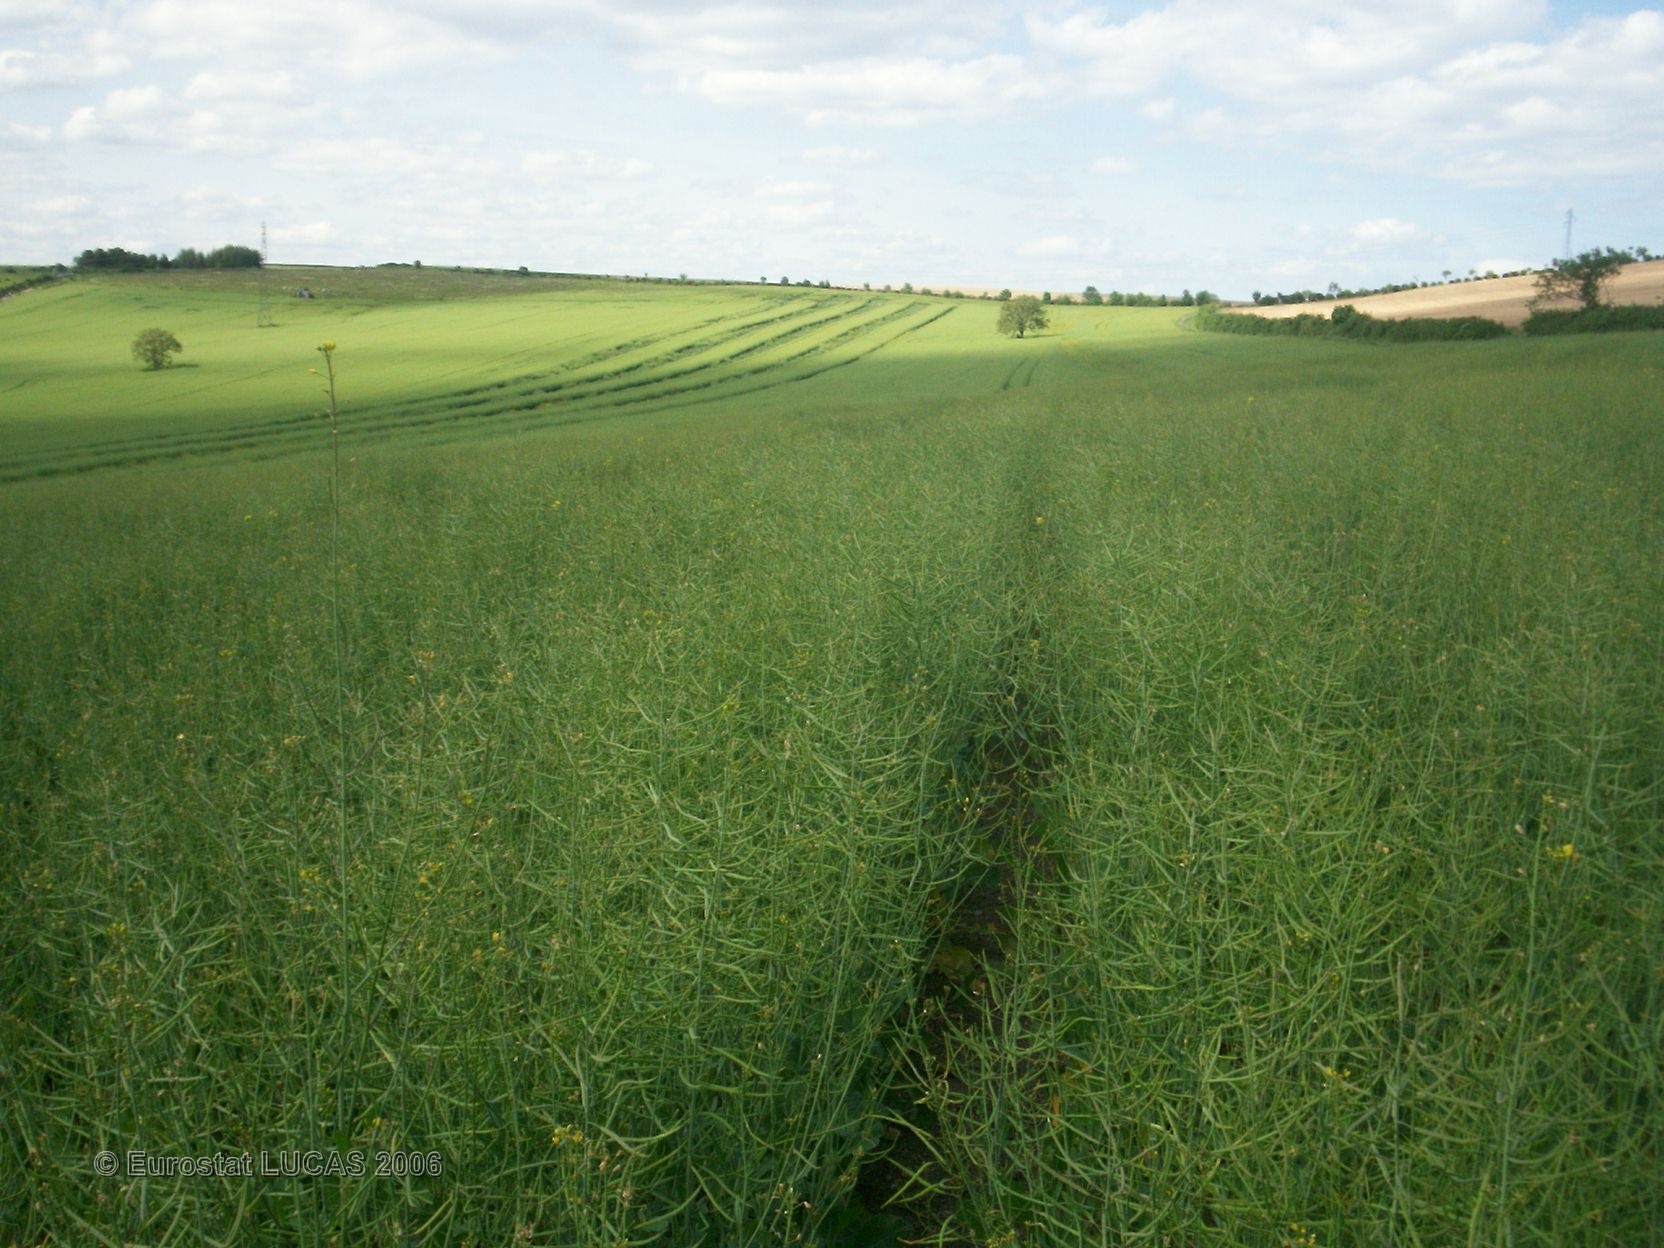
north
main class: Cropland
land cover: Rape and turnip rape
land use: Agriculture (excluding fallow land and kitchen gardens)
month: May
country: FR
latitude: 45.7535
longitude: 3.1738
